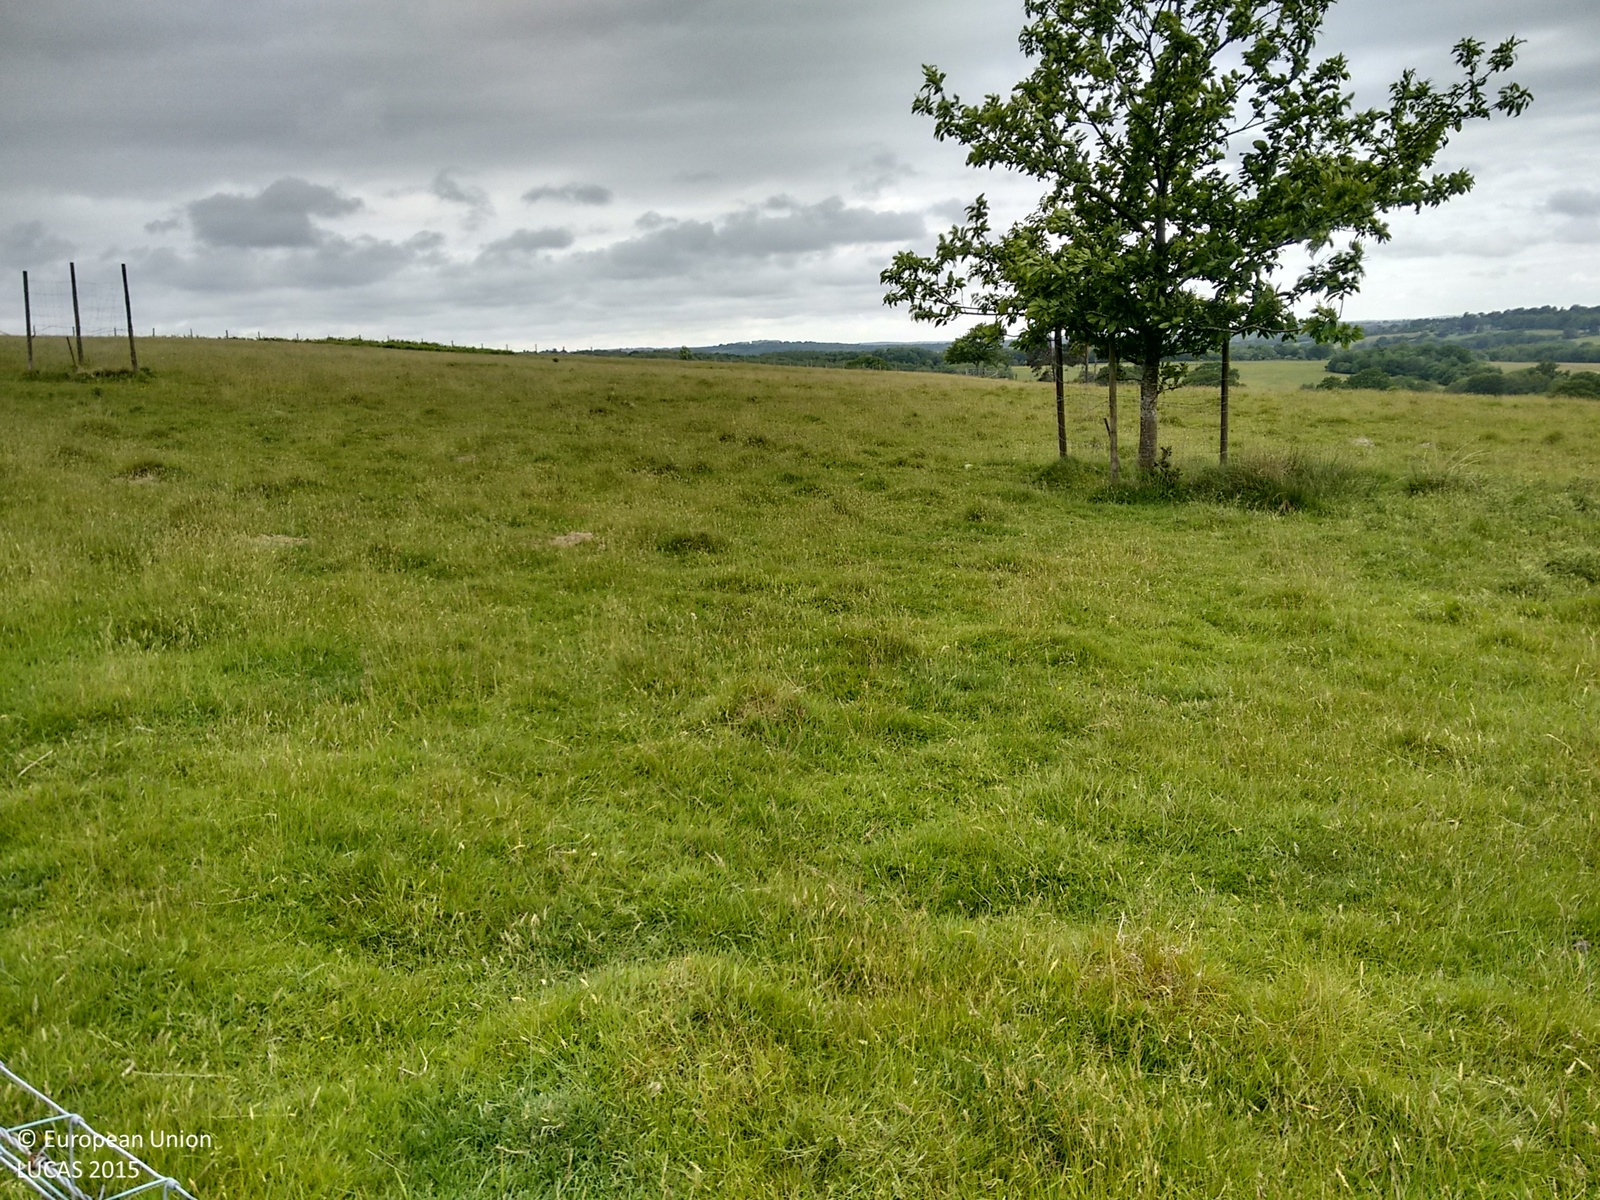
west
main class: Grassland
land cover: Grassland without tree/shrub cover
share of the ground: > 75 %
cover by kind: herbaceous plants 100 %
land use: Agriculture (excluding fallow land and kitchen gardens)
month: June
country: GB
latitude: 51.0875
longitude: 0.2473
